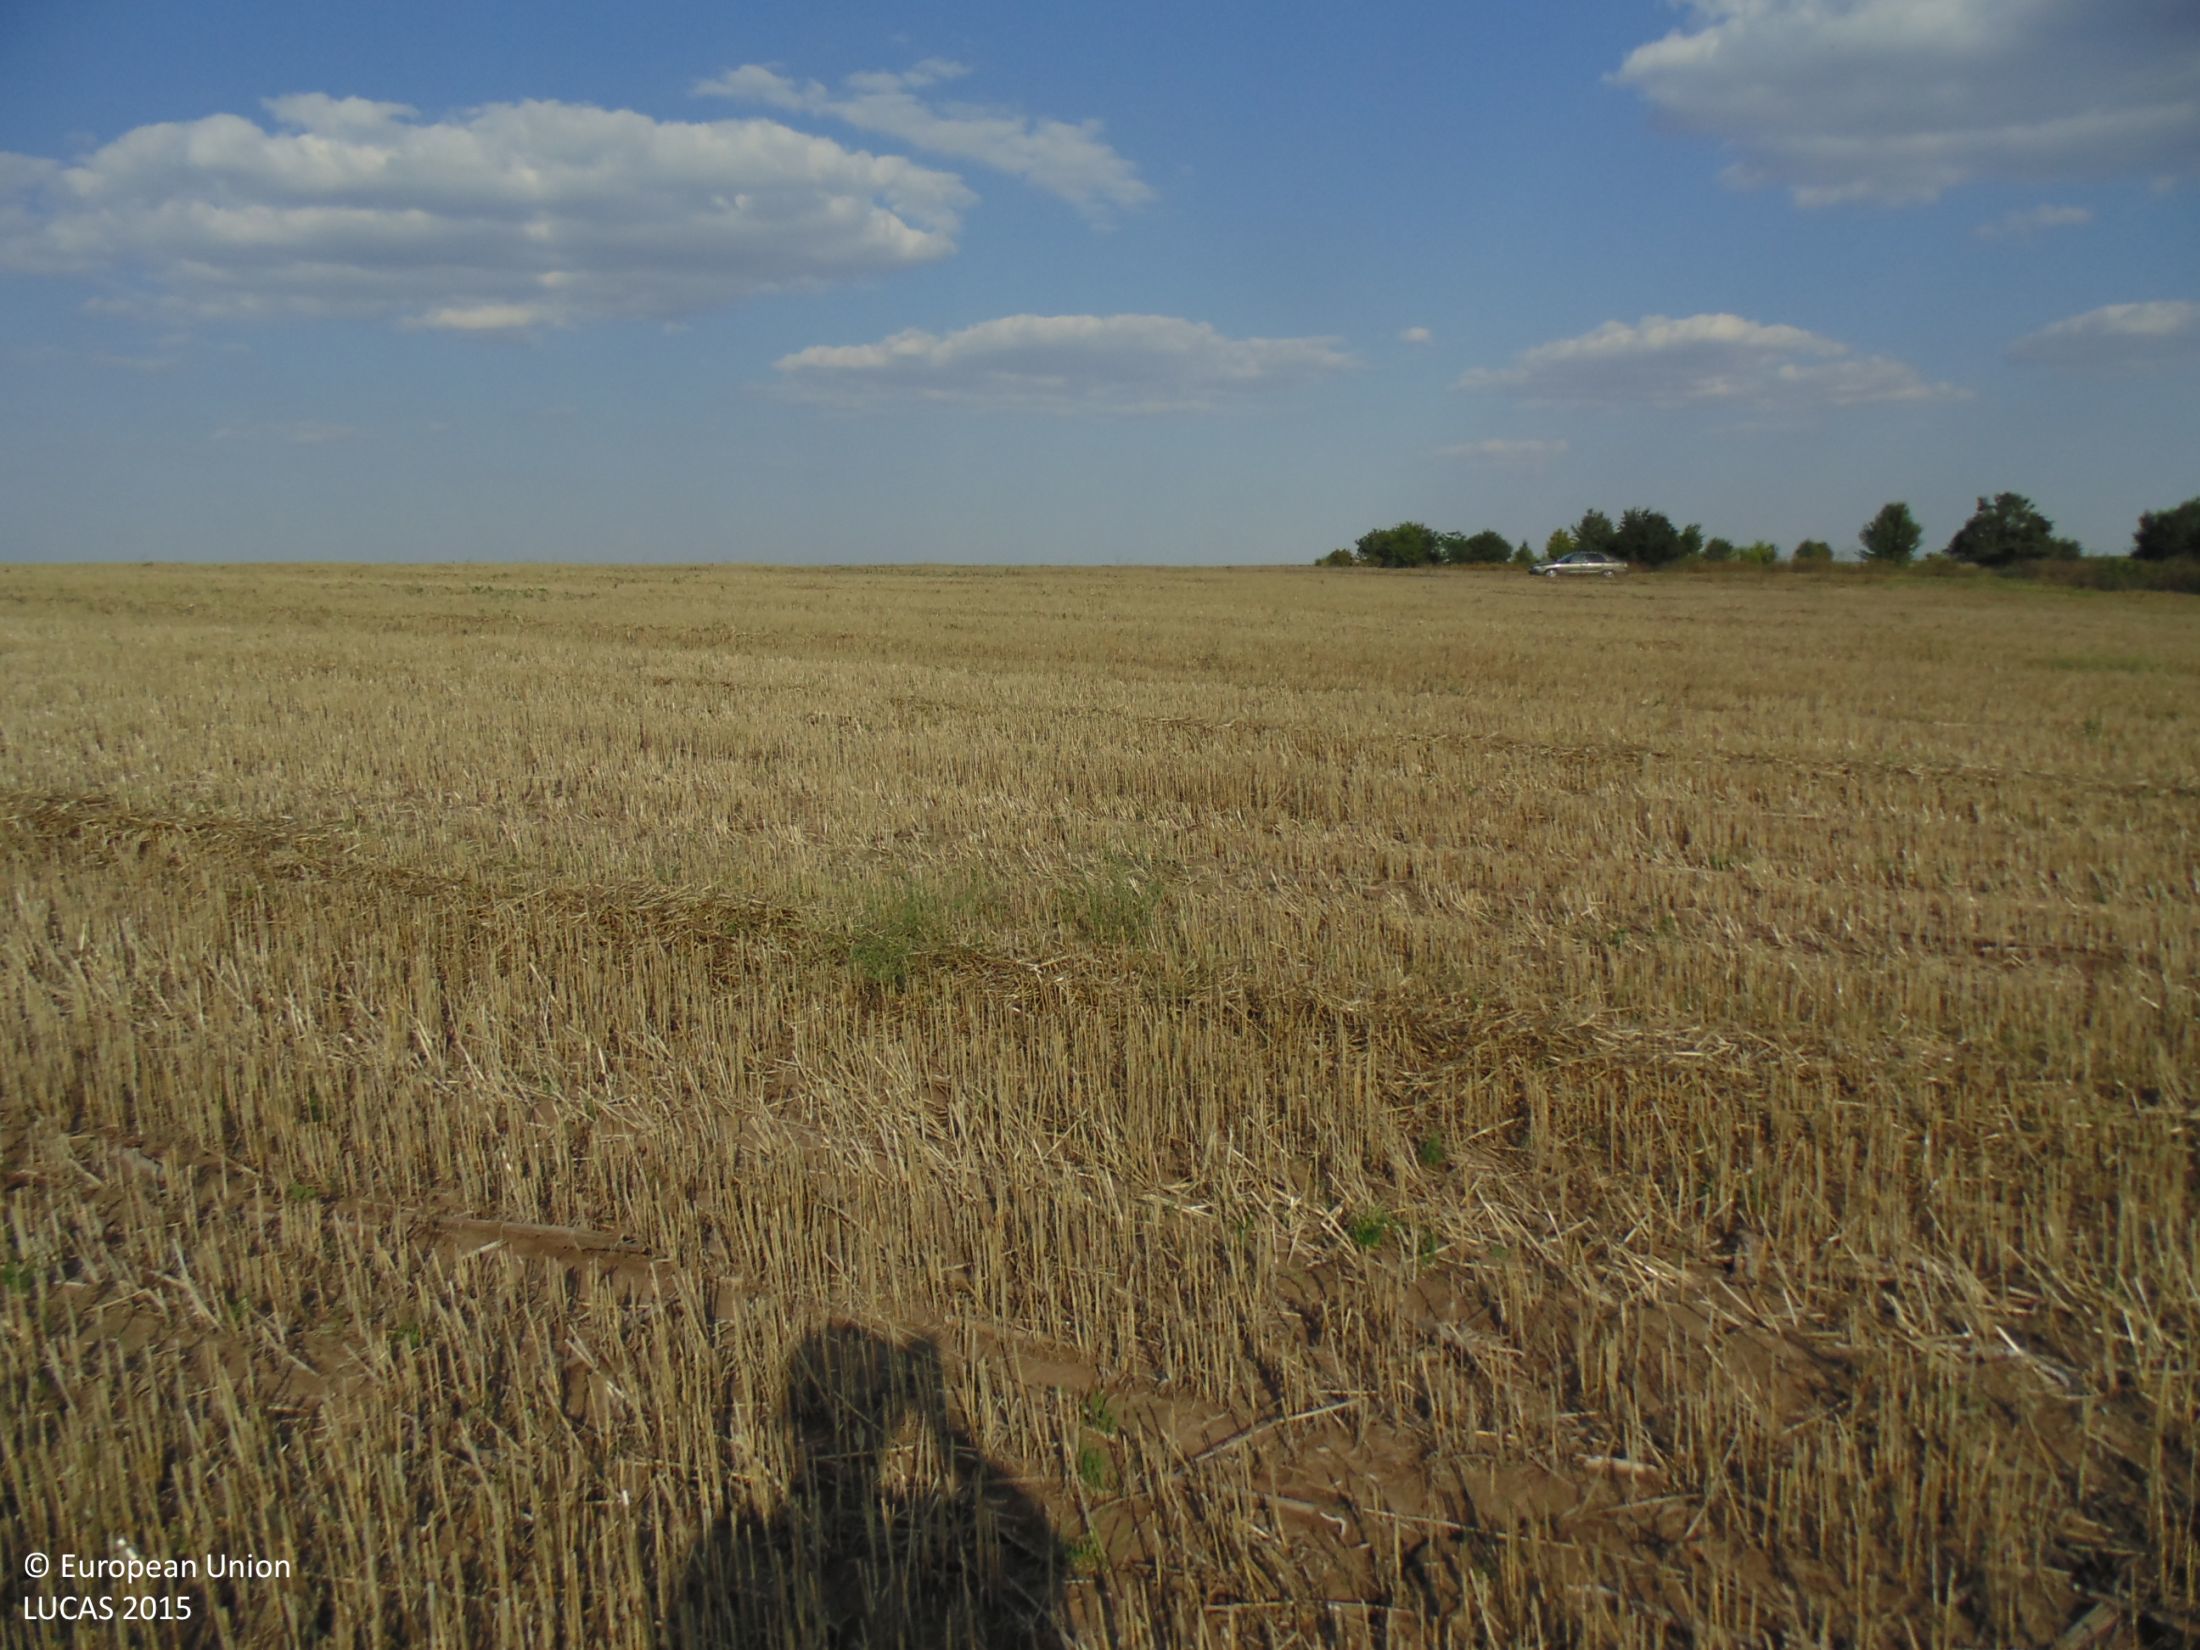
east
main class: Cropland
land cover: Common wheat
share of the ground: 50 - 75 %
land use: Agriculture (excluding fallow land and kitchen gardens)
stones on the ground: < 10 %
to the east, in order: Common wheat; Grass margins; Tracks; Grass margins; Common wheat
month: August
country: BG
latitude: 43.7396
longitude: 27.2496
